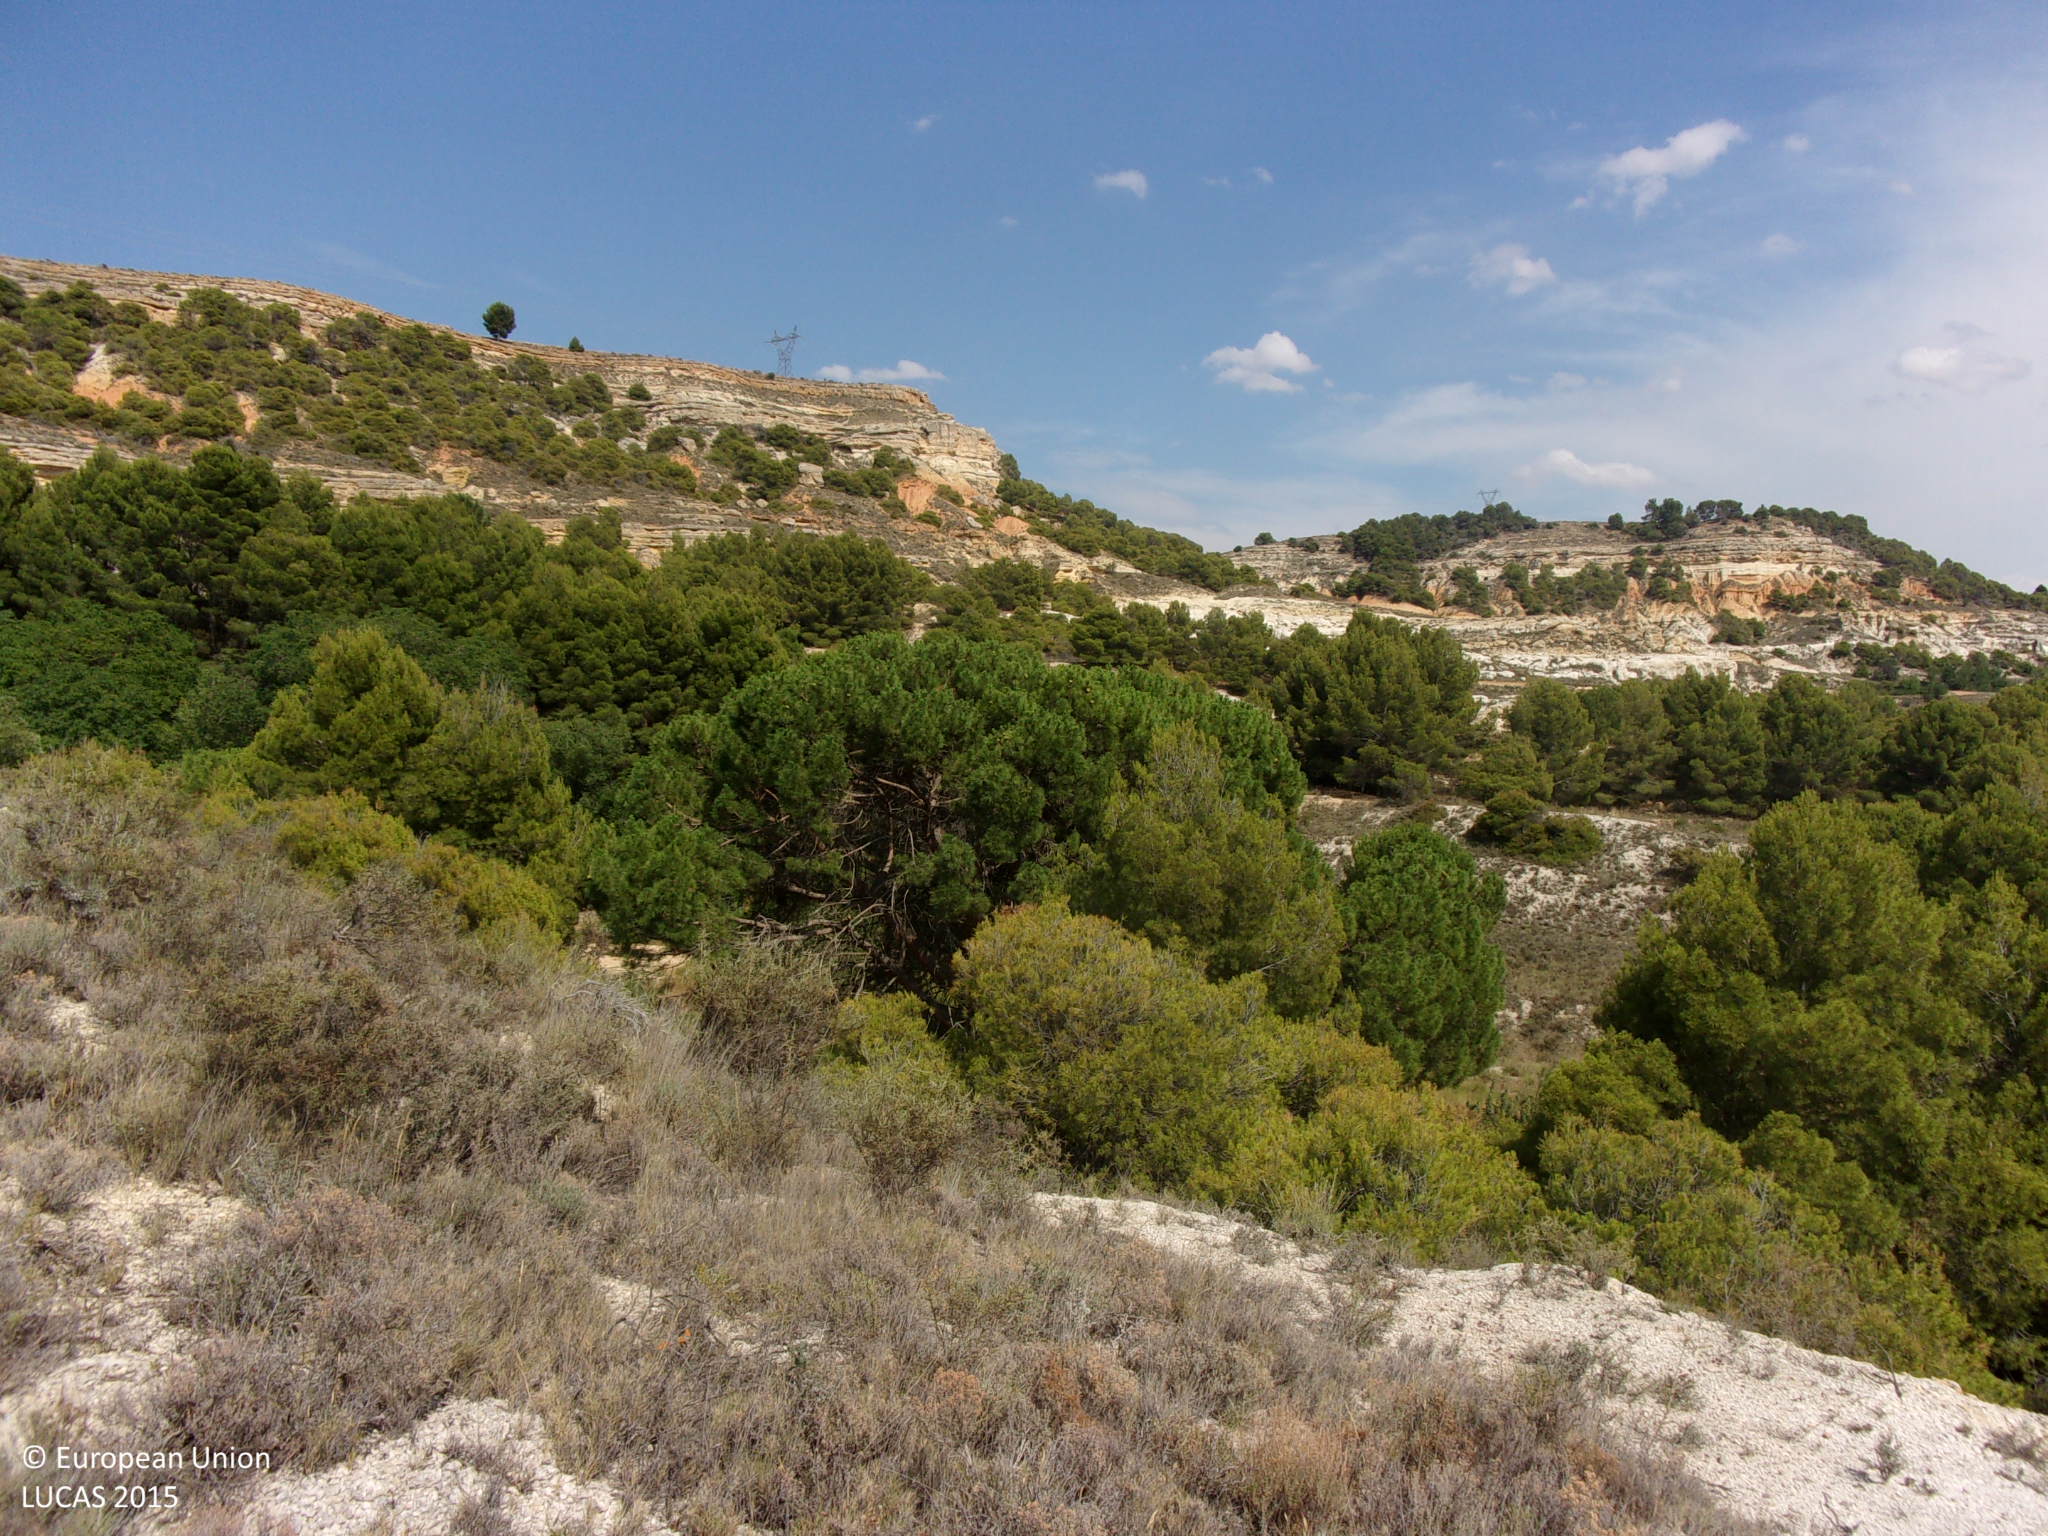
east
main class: Shrubland
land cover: Shrubland without tree cover
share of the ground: 50 - 75 %
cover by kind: shrubs 60 %, consolidated bare surface 30 %, herbaceous plants 10 %
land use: Semi-natural and natural areas not in use
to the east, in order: Shrubland without tree cover; Pine dominated coniferous woodland; Other bare soil; Shruby margins; Other bare soil; Pine dominated coniferous woodland; Tracks; Pine dominated coniferous woodland; Shrubland with sparse tree cover
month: July
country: ES
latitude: 41.1184
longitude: -1.3706
